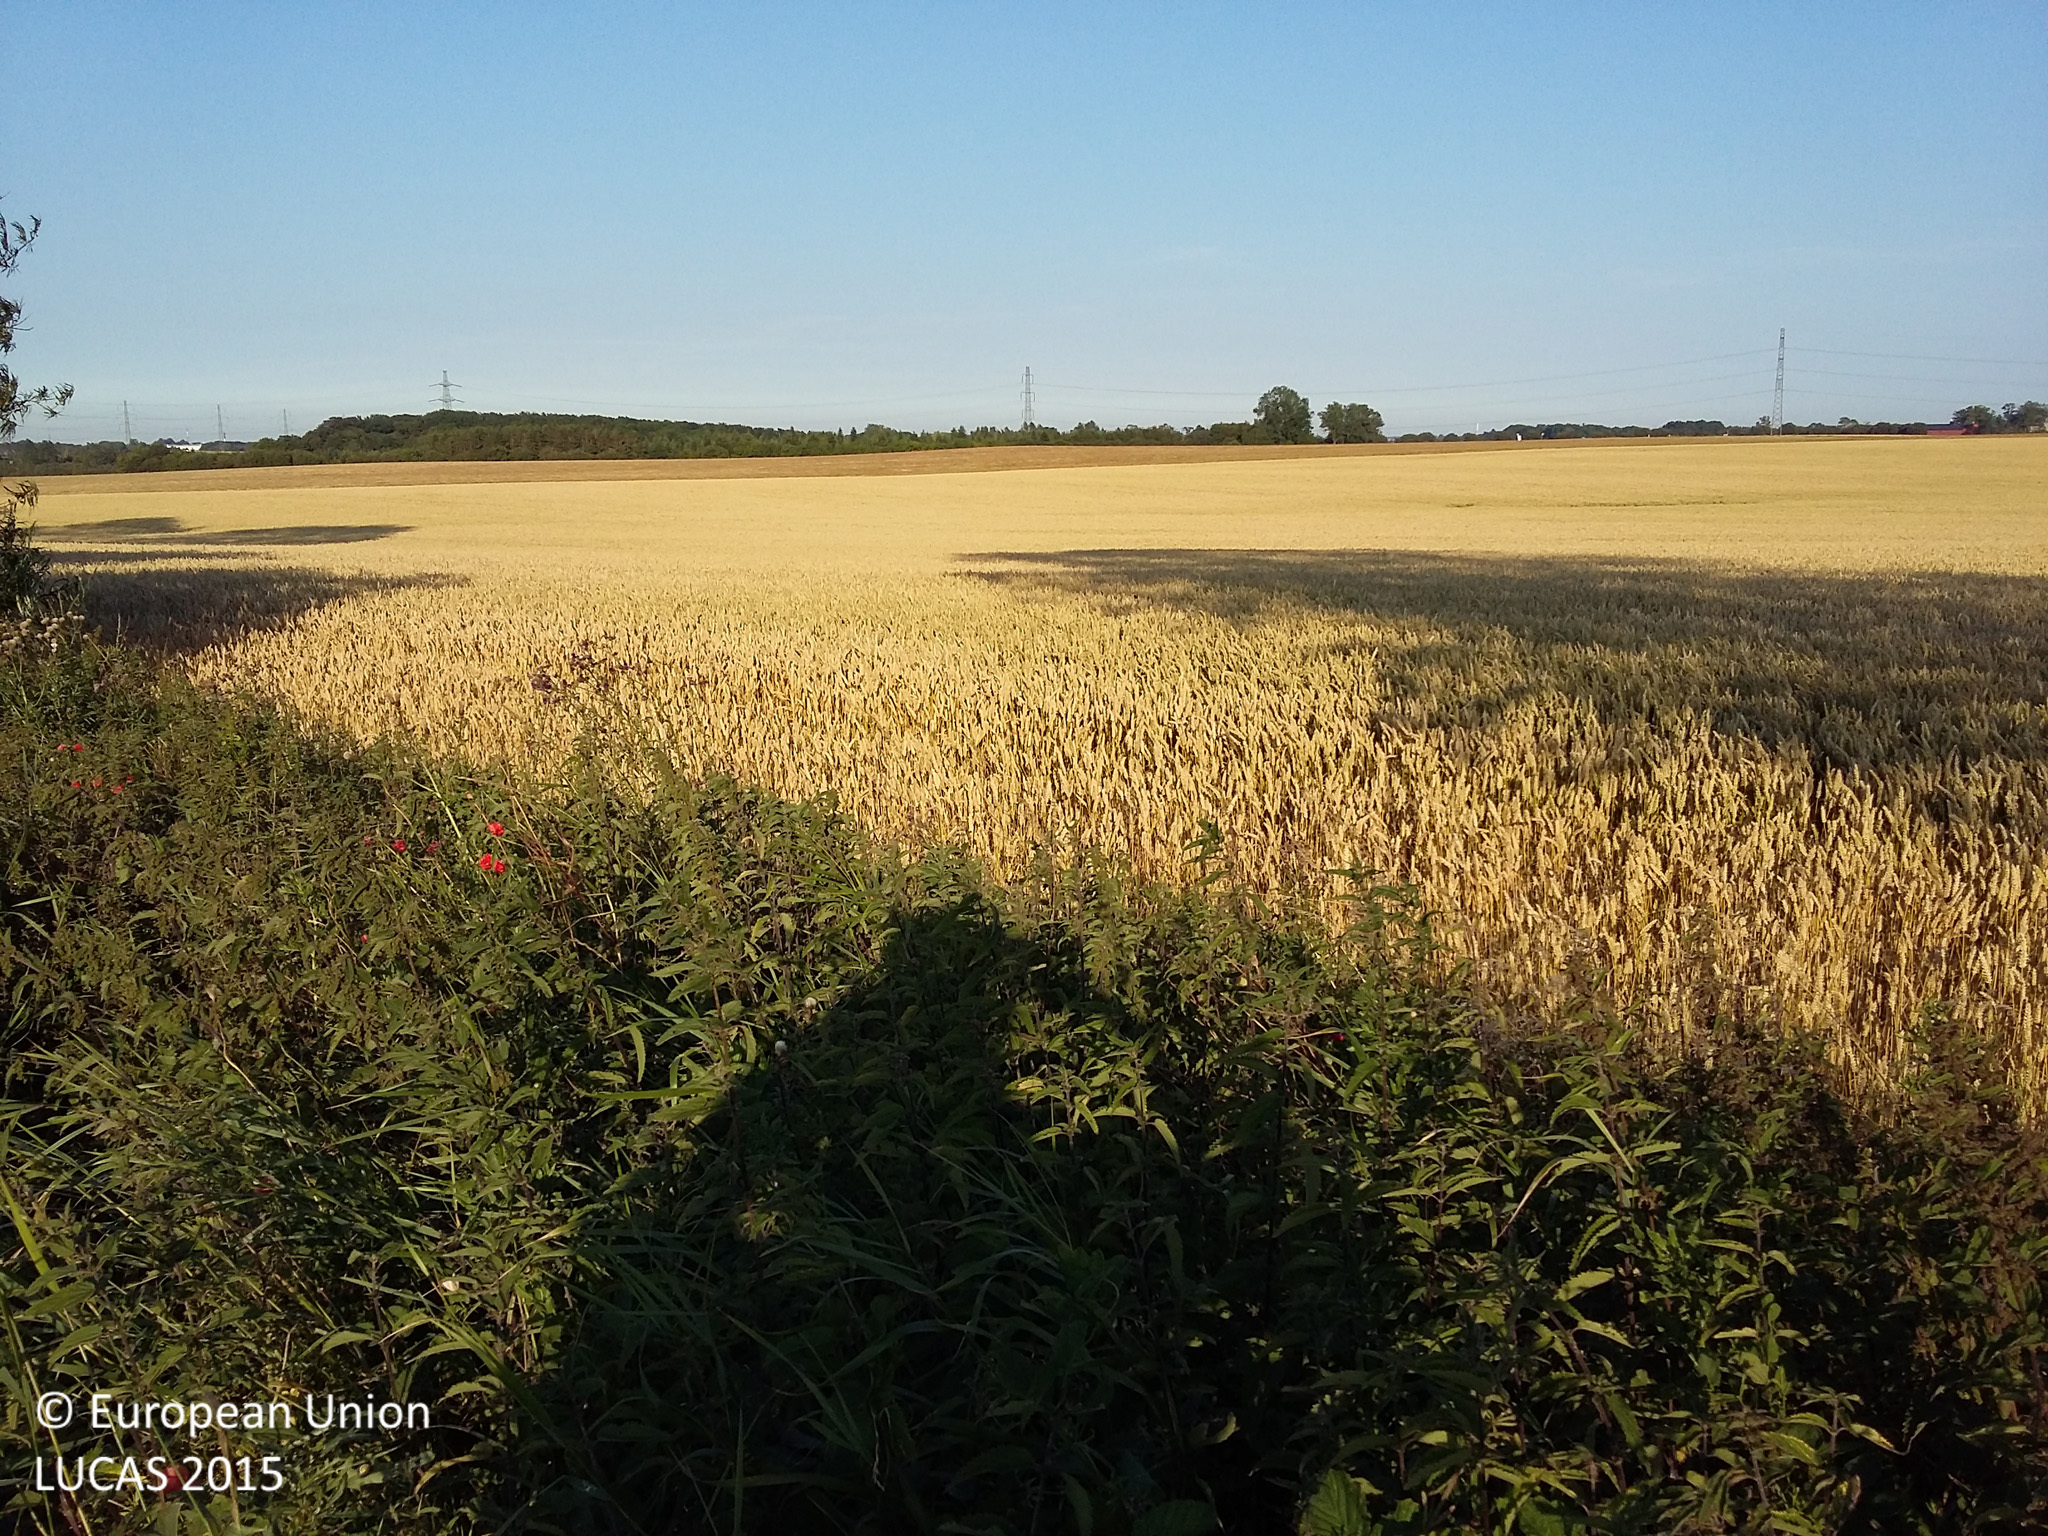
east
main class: Woodland
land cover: Broadleaved woodland
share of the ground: 25 - 50 %
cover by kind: herbaceous plants 60 %, broadleaved forest trees 40 %
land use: Agriculture (excluding fallow land and kitchen gardens)
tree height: > 5 m
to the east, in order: Broadleaved woodland; Common wheat; Barley
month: August
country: DK
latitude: 55.6294
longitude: 12.2059
